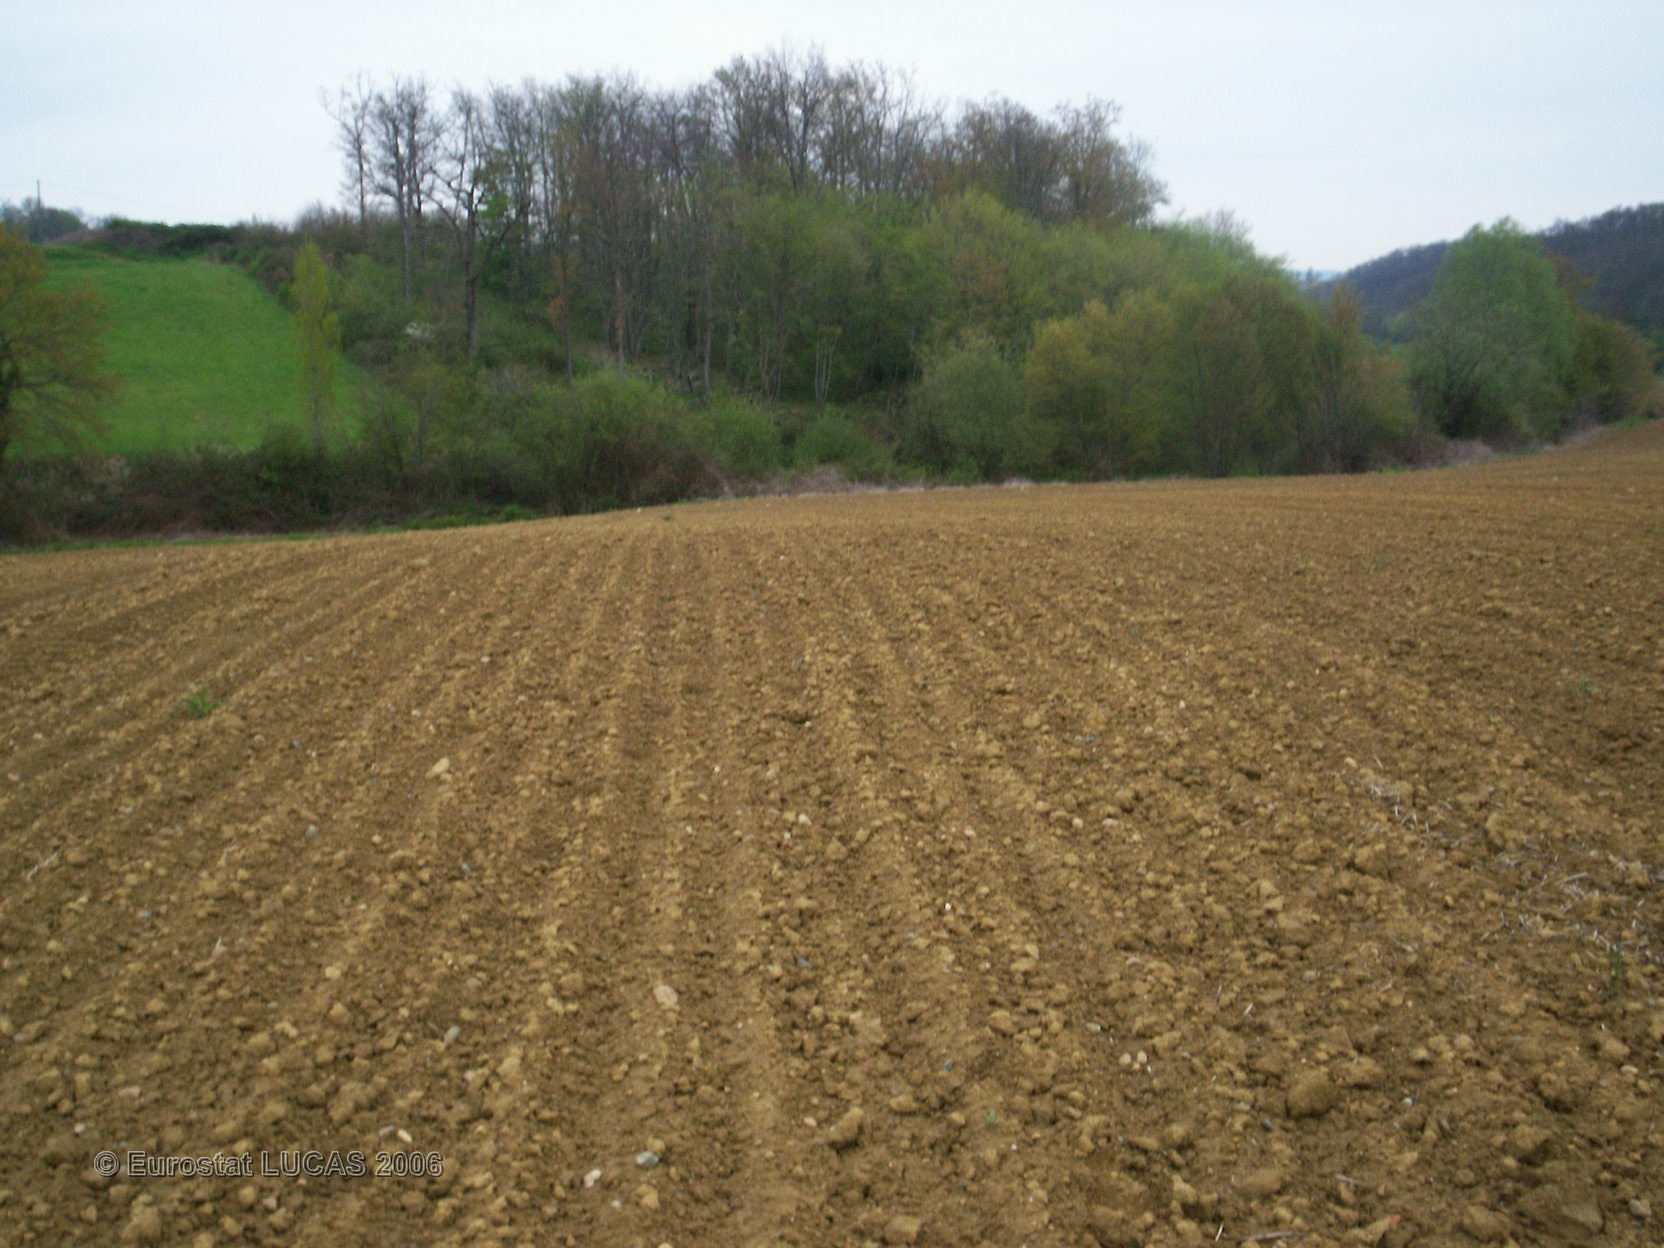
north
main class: Cropland
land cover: Maize
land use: Agriculture (excluding fallow land and kitchen gardens)
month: June
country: FR
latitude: 43.5684
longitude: 0.3016
